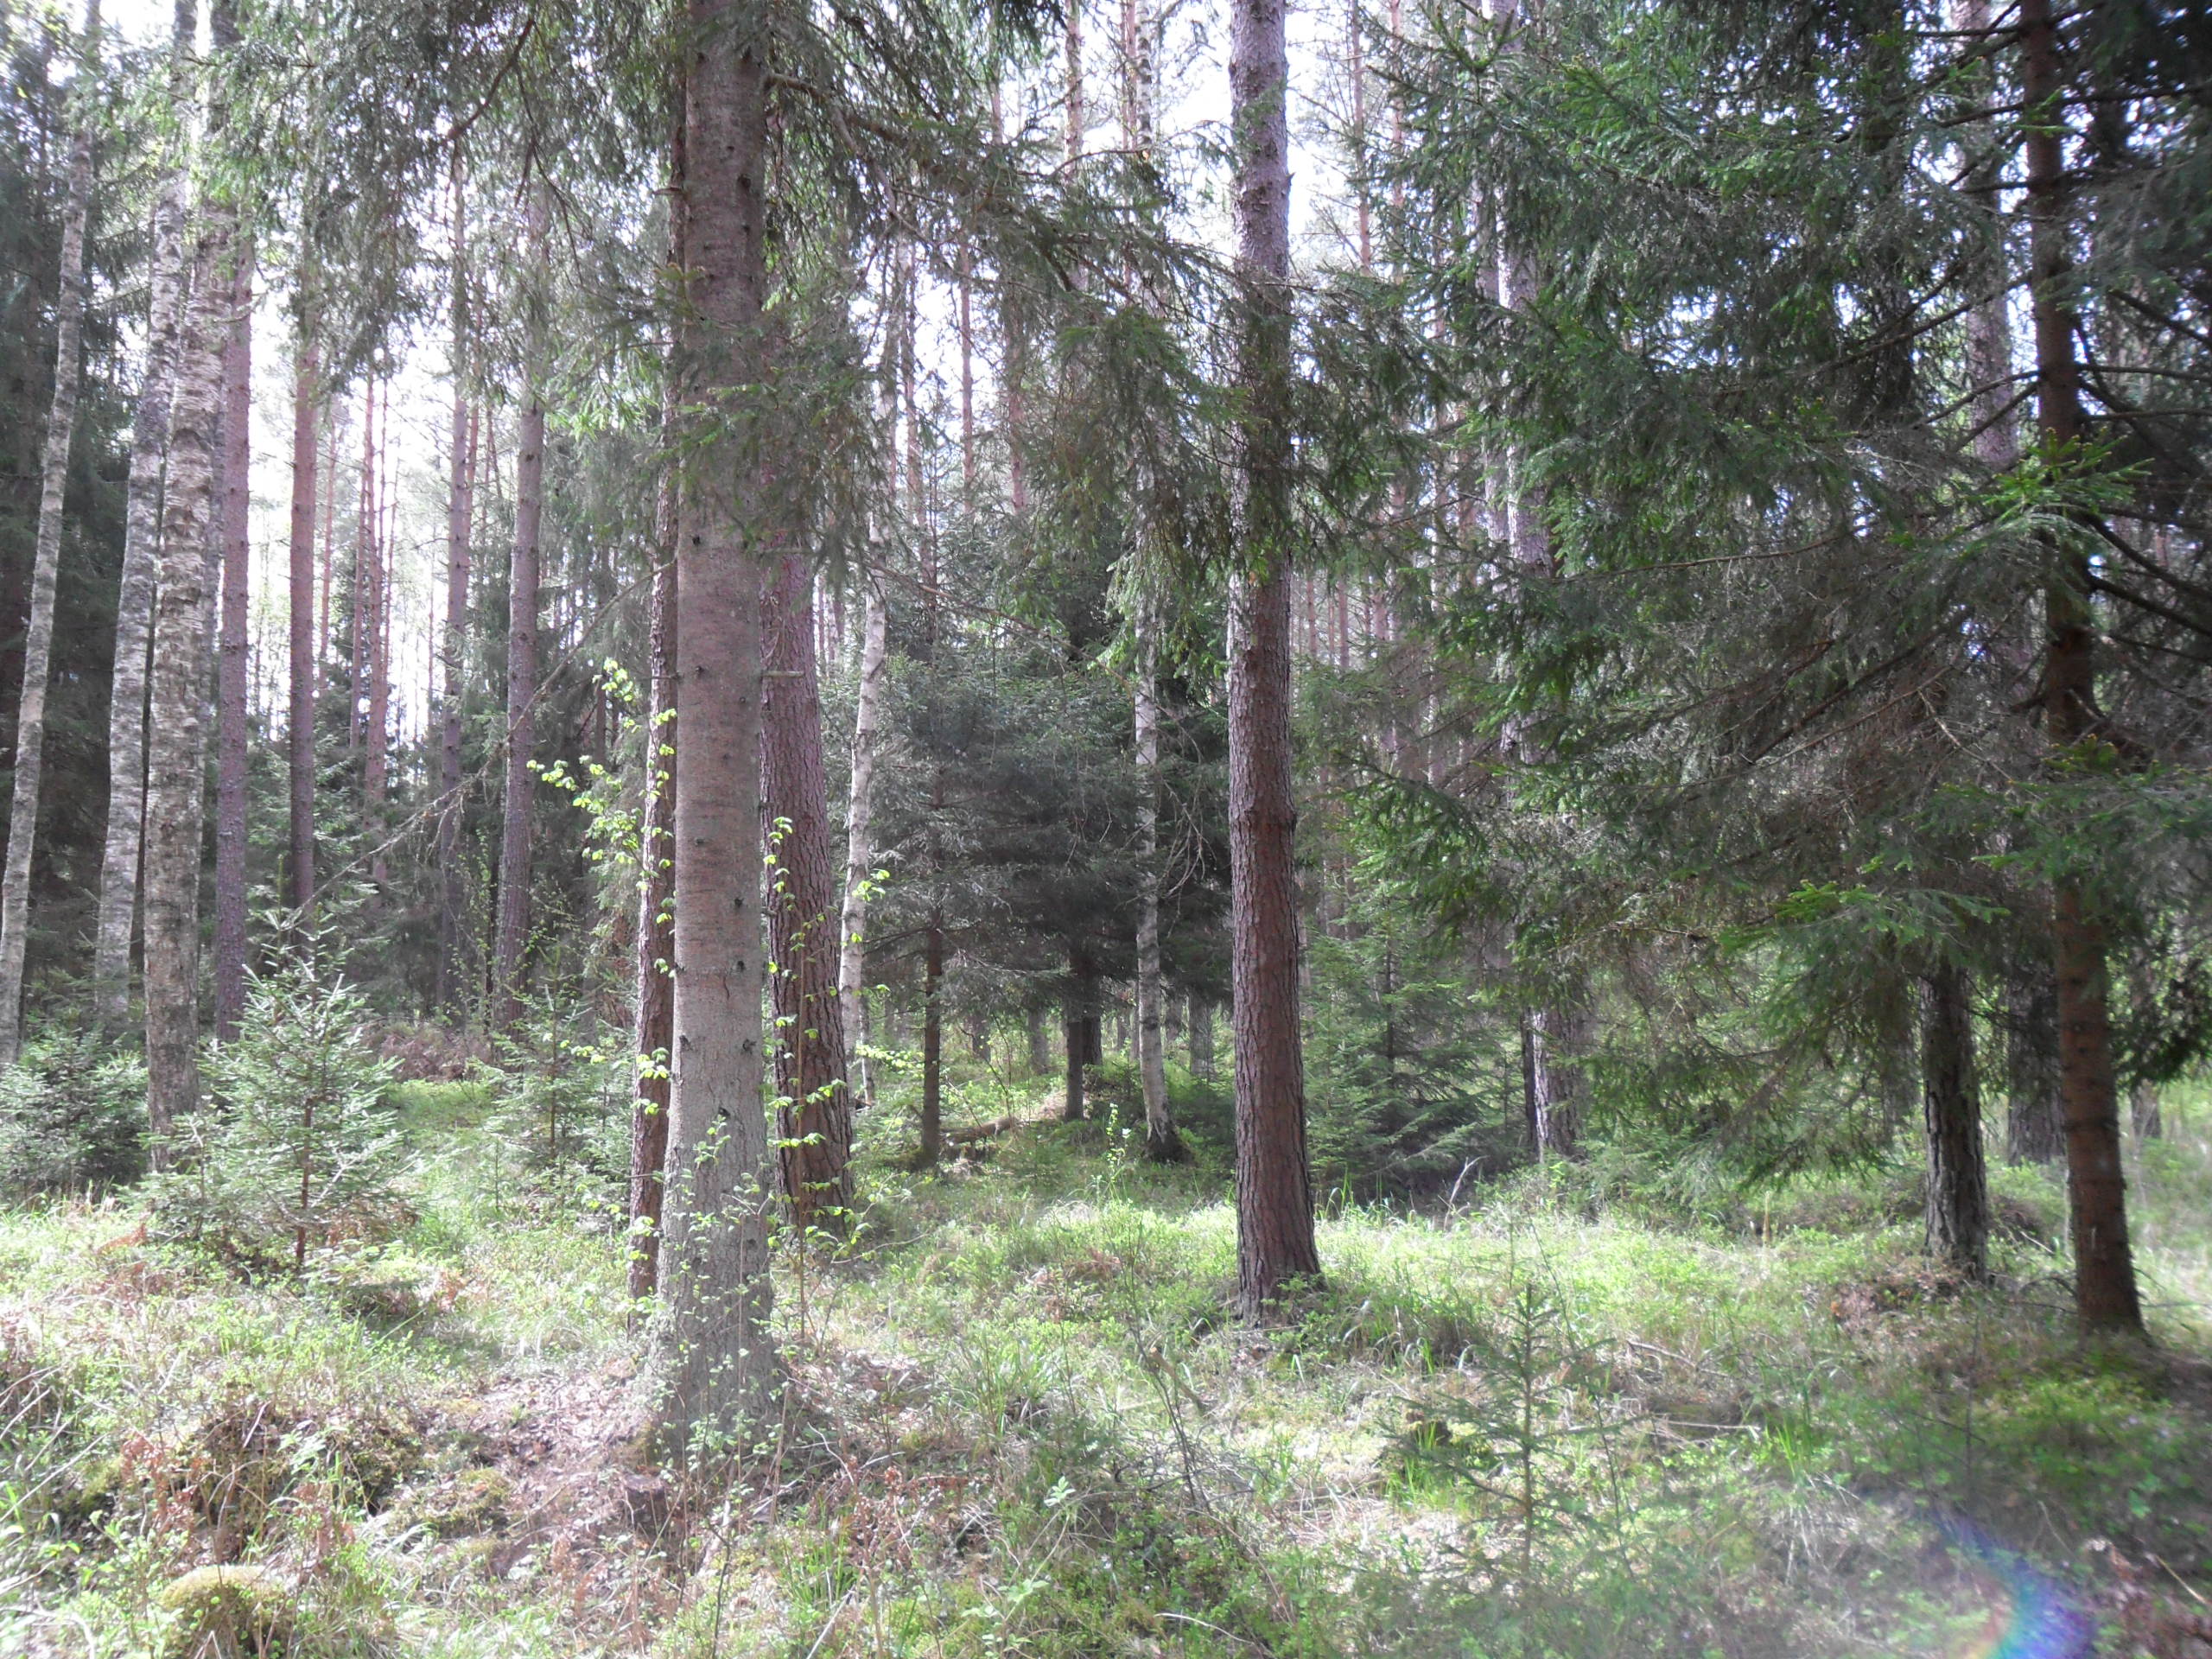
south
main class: Woodland
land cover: Pine dominated mixed woodland
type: hemiboreal forest and nemoral coniferous forest and mixed broadleaved-coniferous forest
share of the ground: > 75 %
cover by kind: coniferous forest trees 75 %, broadleaved forest trees 25 %
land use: Forestry
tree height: > 5 m
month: May
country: LV
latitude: 57.3322
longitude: 22.9682
